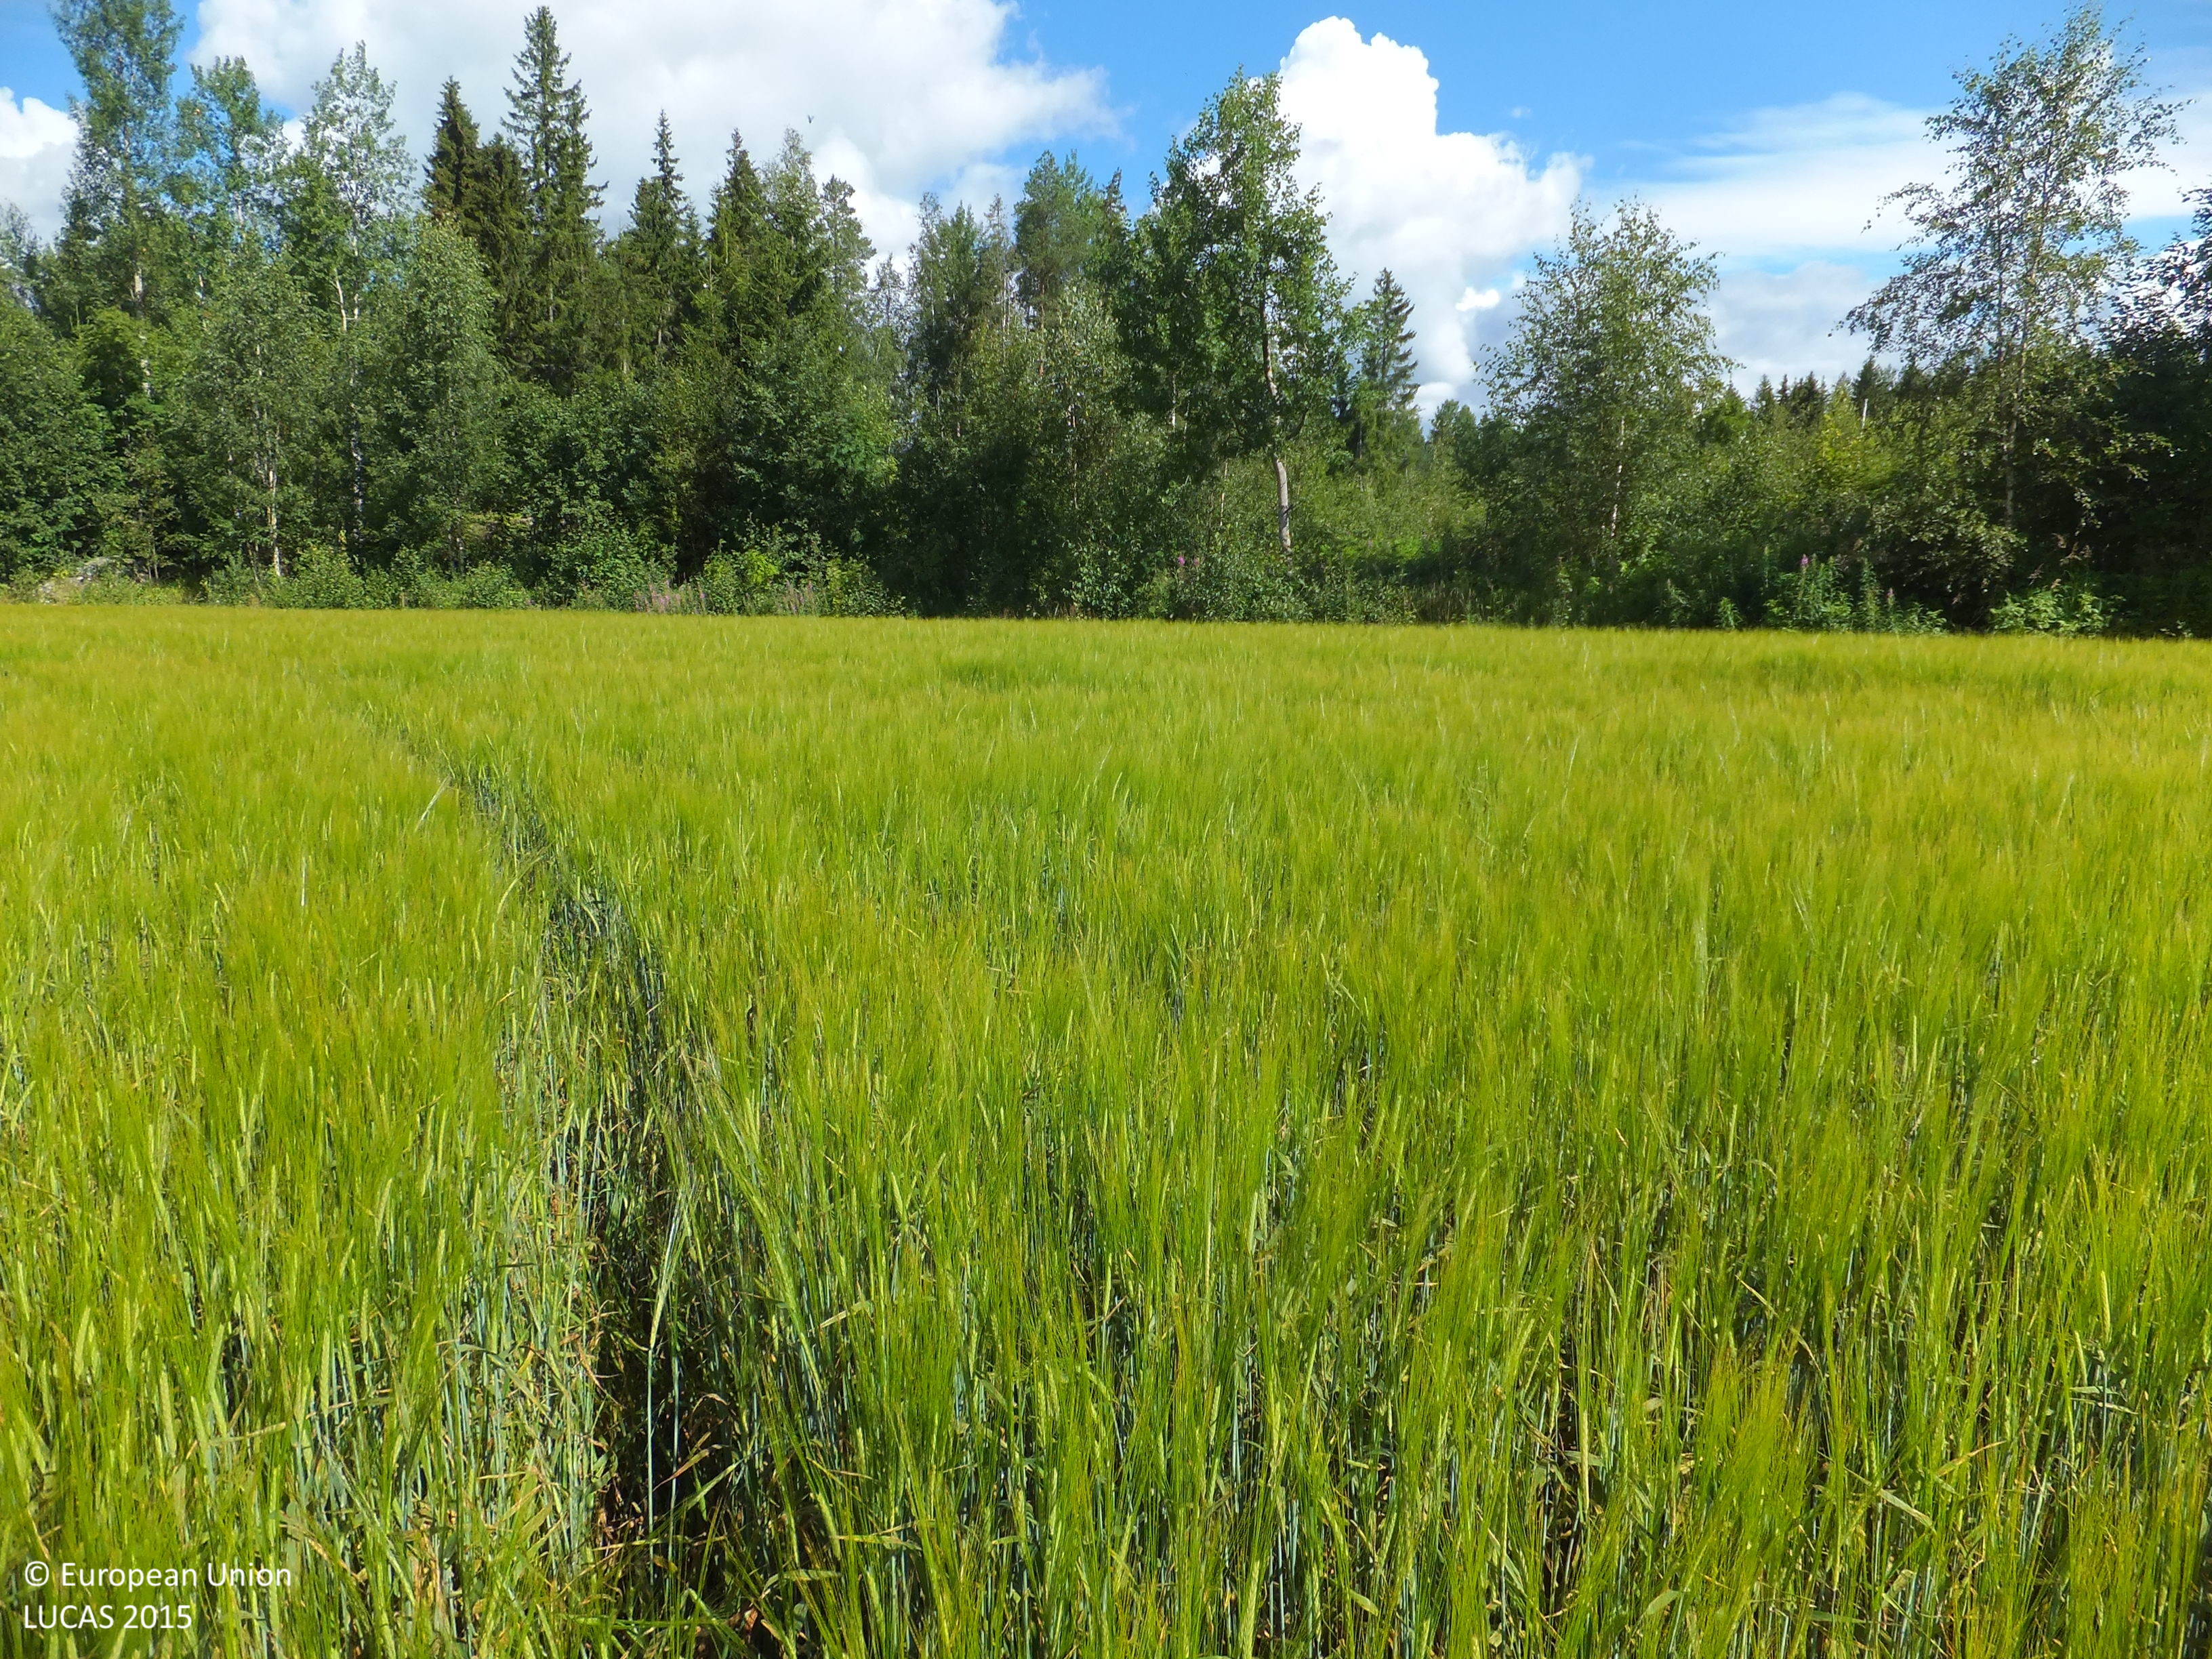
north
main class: Cropland
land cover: Barley
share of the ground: > 75 %
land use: Agriculture (excluding fallow land and kitchen gardens)
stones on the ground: < 10 %
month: August
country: FI
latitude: 63.0932
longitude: 22.7504
